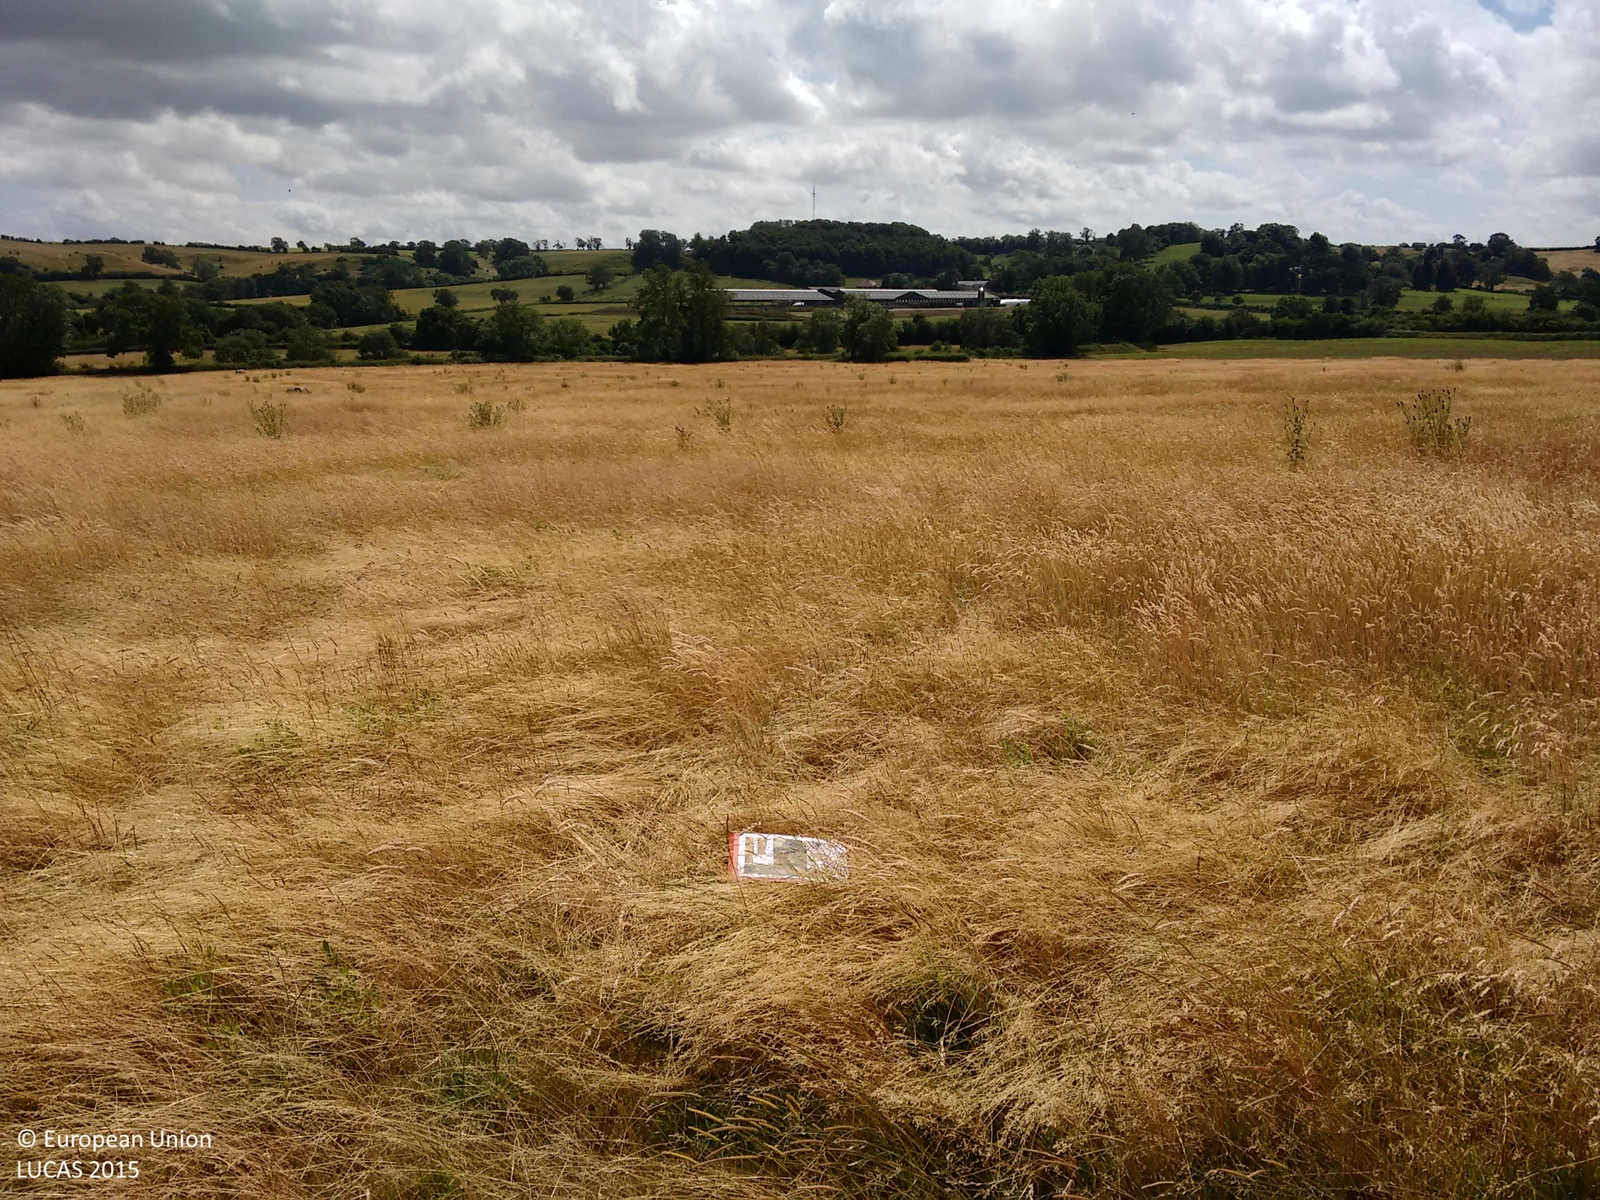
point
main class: Grassland
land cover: Grassland without tree/shrub cover
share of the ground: > 75 %
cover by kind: herbaceous plants 100 %
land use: Agriculture (excluding fallow land and kitchen gardens)
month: July
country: GB
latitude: 52.6508
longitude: -0.9373
